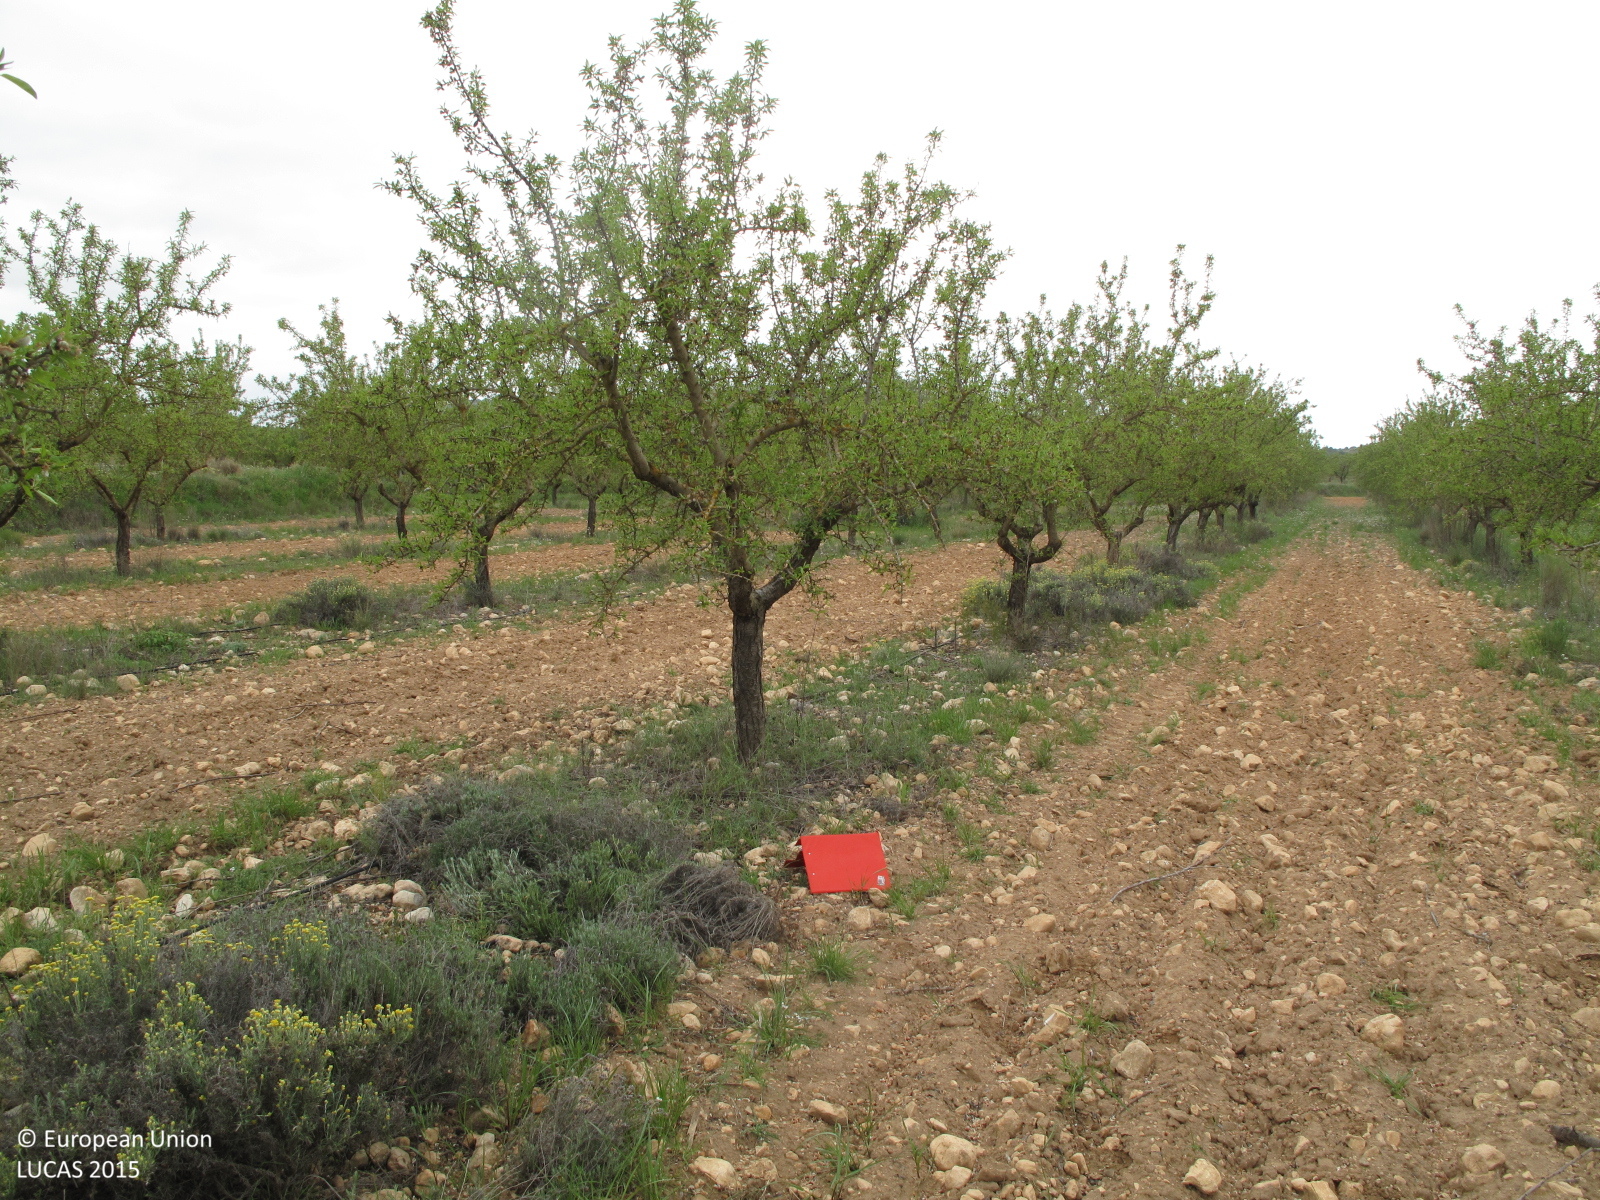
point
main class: Cropland
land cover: Nuts trees
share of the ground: 50 - 75 %
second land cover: Grassland without tree/shrub cover
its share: 25 - 50 %
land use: Agriculture (excluding fallow land and kitchen gardens)
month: April
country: ES
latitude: 38.5752
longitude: -0.9518
